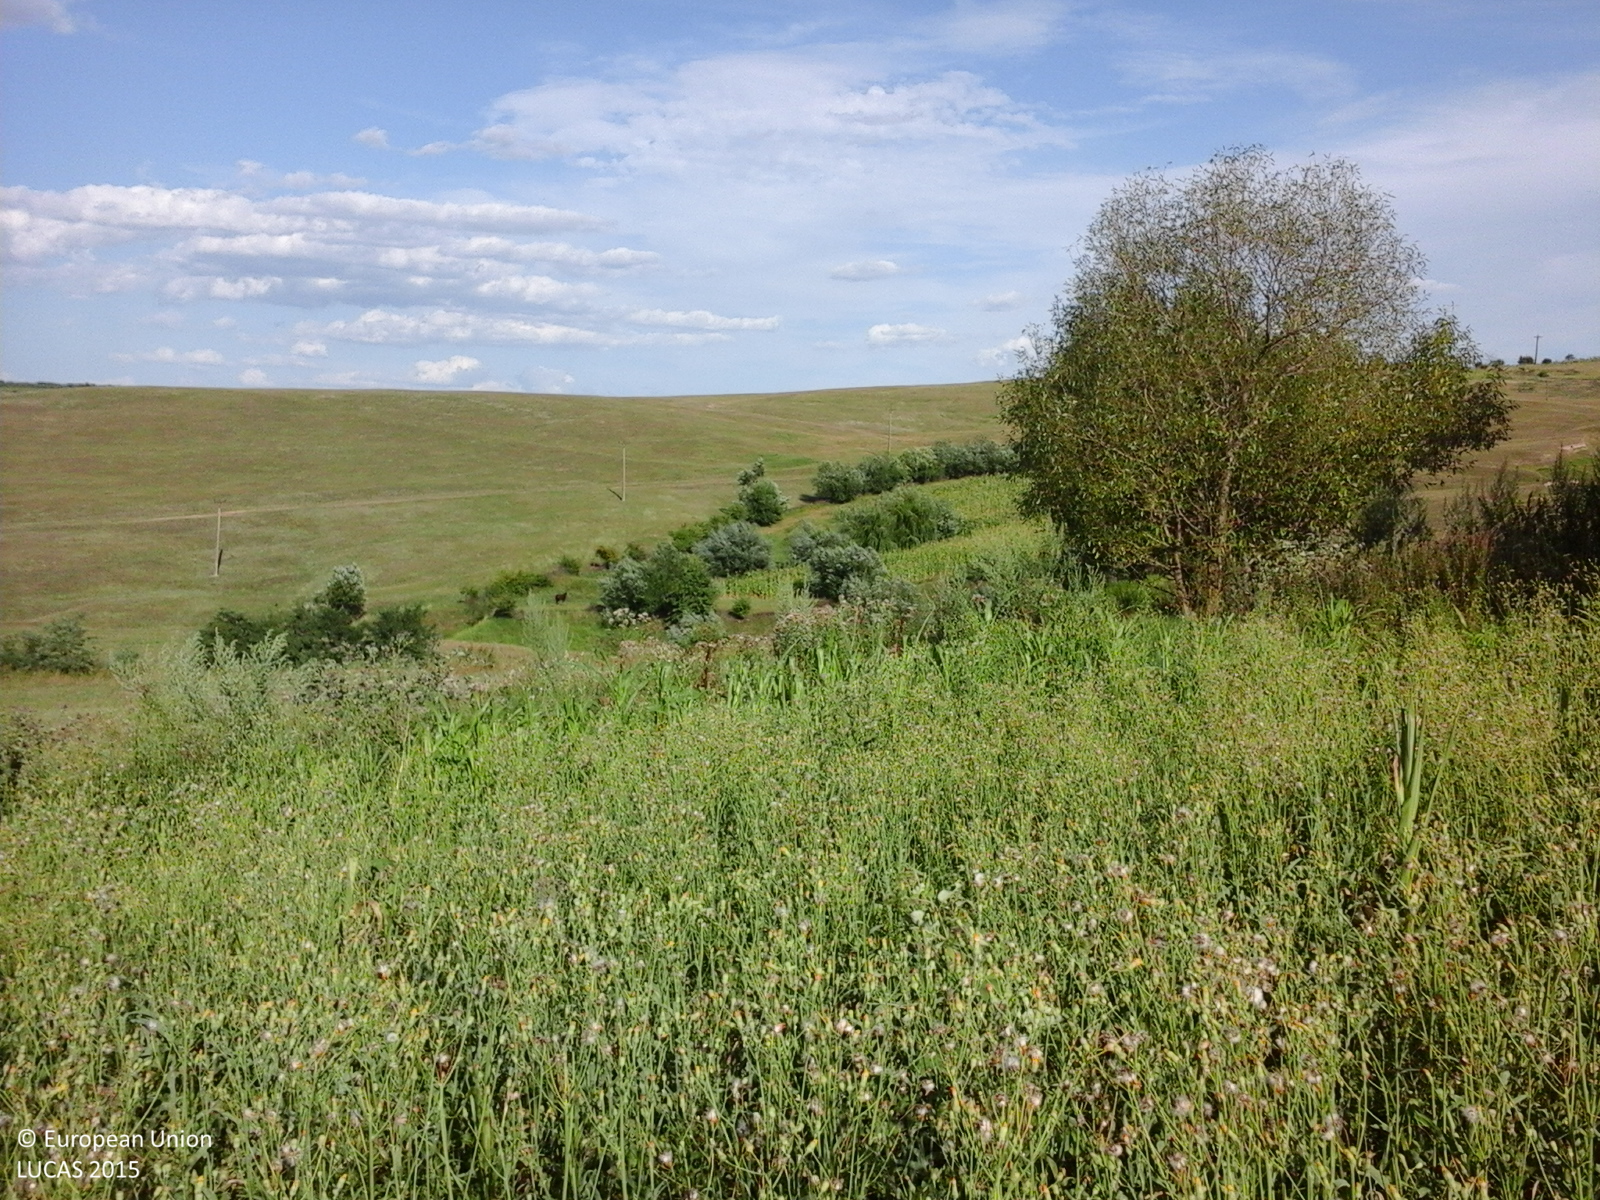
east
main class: Cropland
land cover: Maize
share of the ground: > 75 %
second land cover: Spontaneously vegetated surfaces
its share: > 75 %
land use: Agriculture (excluding fallow land and kitchen gardens)
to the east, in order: Maize; Spontaneously vegetated surfaces; Grassland without tree/shrub cover; Lucerne; Lines of trees; Grassland without tree/shrub cover; Rivers and streams; Spontaneously vegetated surfaces; Single bushes/trees; Grassland without tree/shrub cover; Electric lines; Grassland without tree/shrub cover
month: July
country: RO
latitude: 46.0390
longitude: 27.6992
